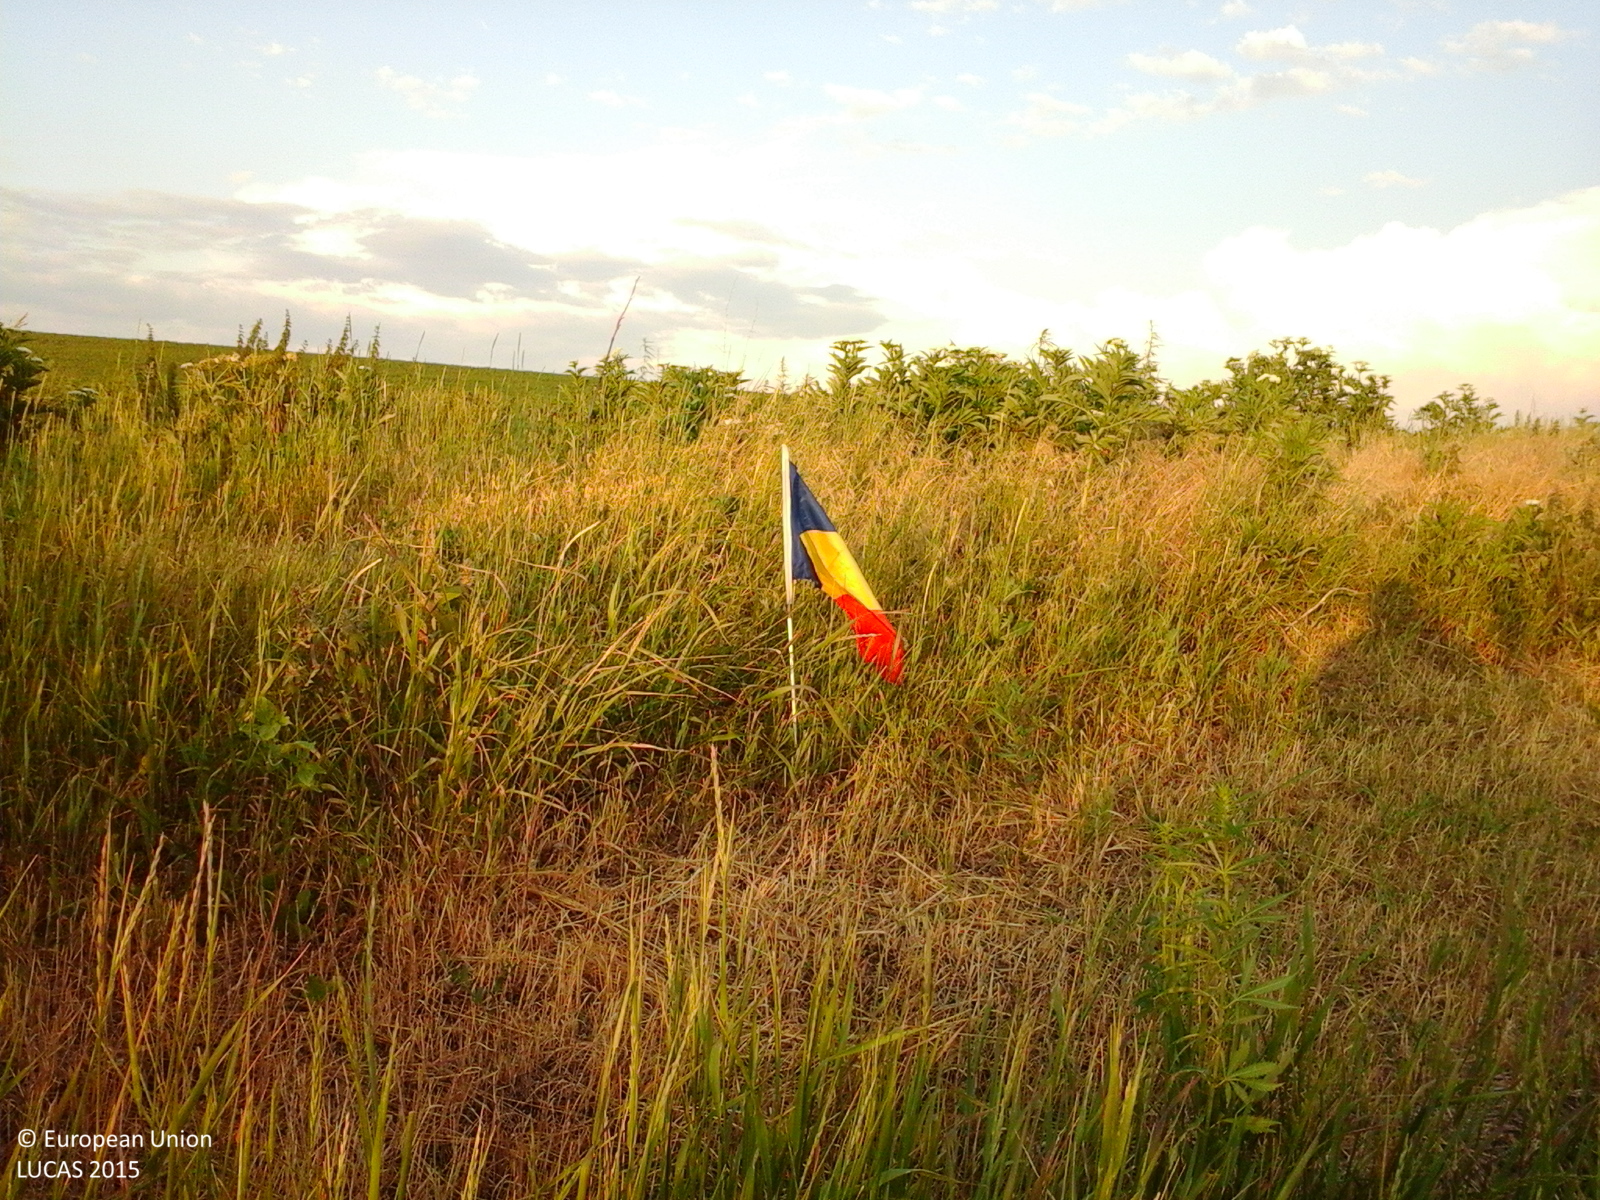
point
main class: Grassland
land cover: Spontaneously vegetated surfaces
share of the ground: > 75 %
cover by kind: herbaceous plants 100 %
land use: Fallow land
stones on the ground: < 10 %
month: June
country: RO
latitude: 46.7489
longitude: 28.0774
